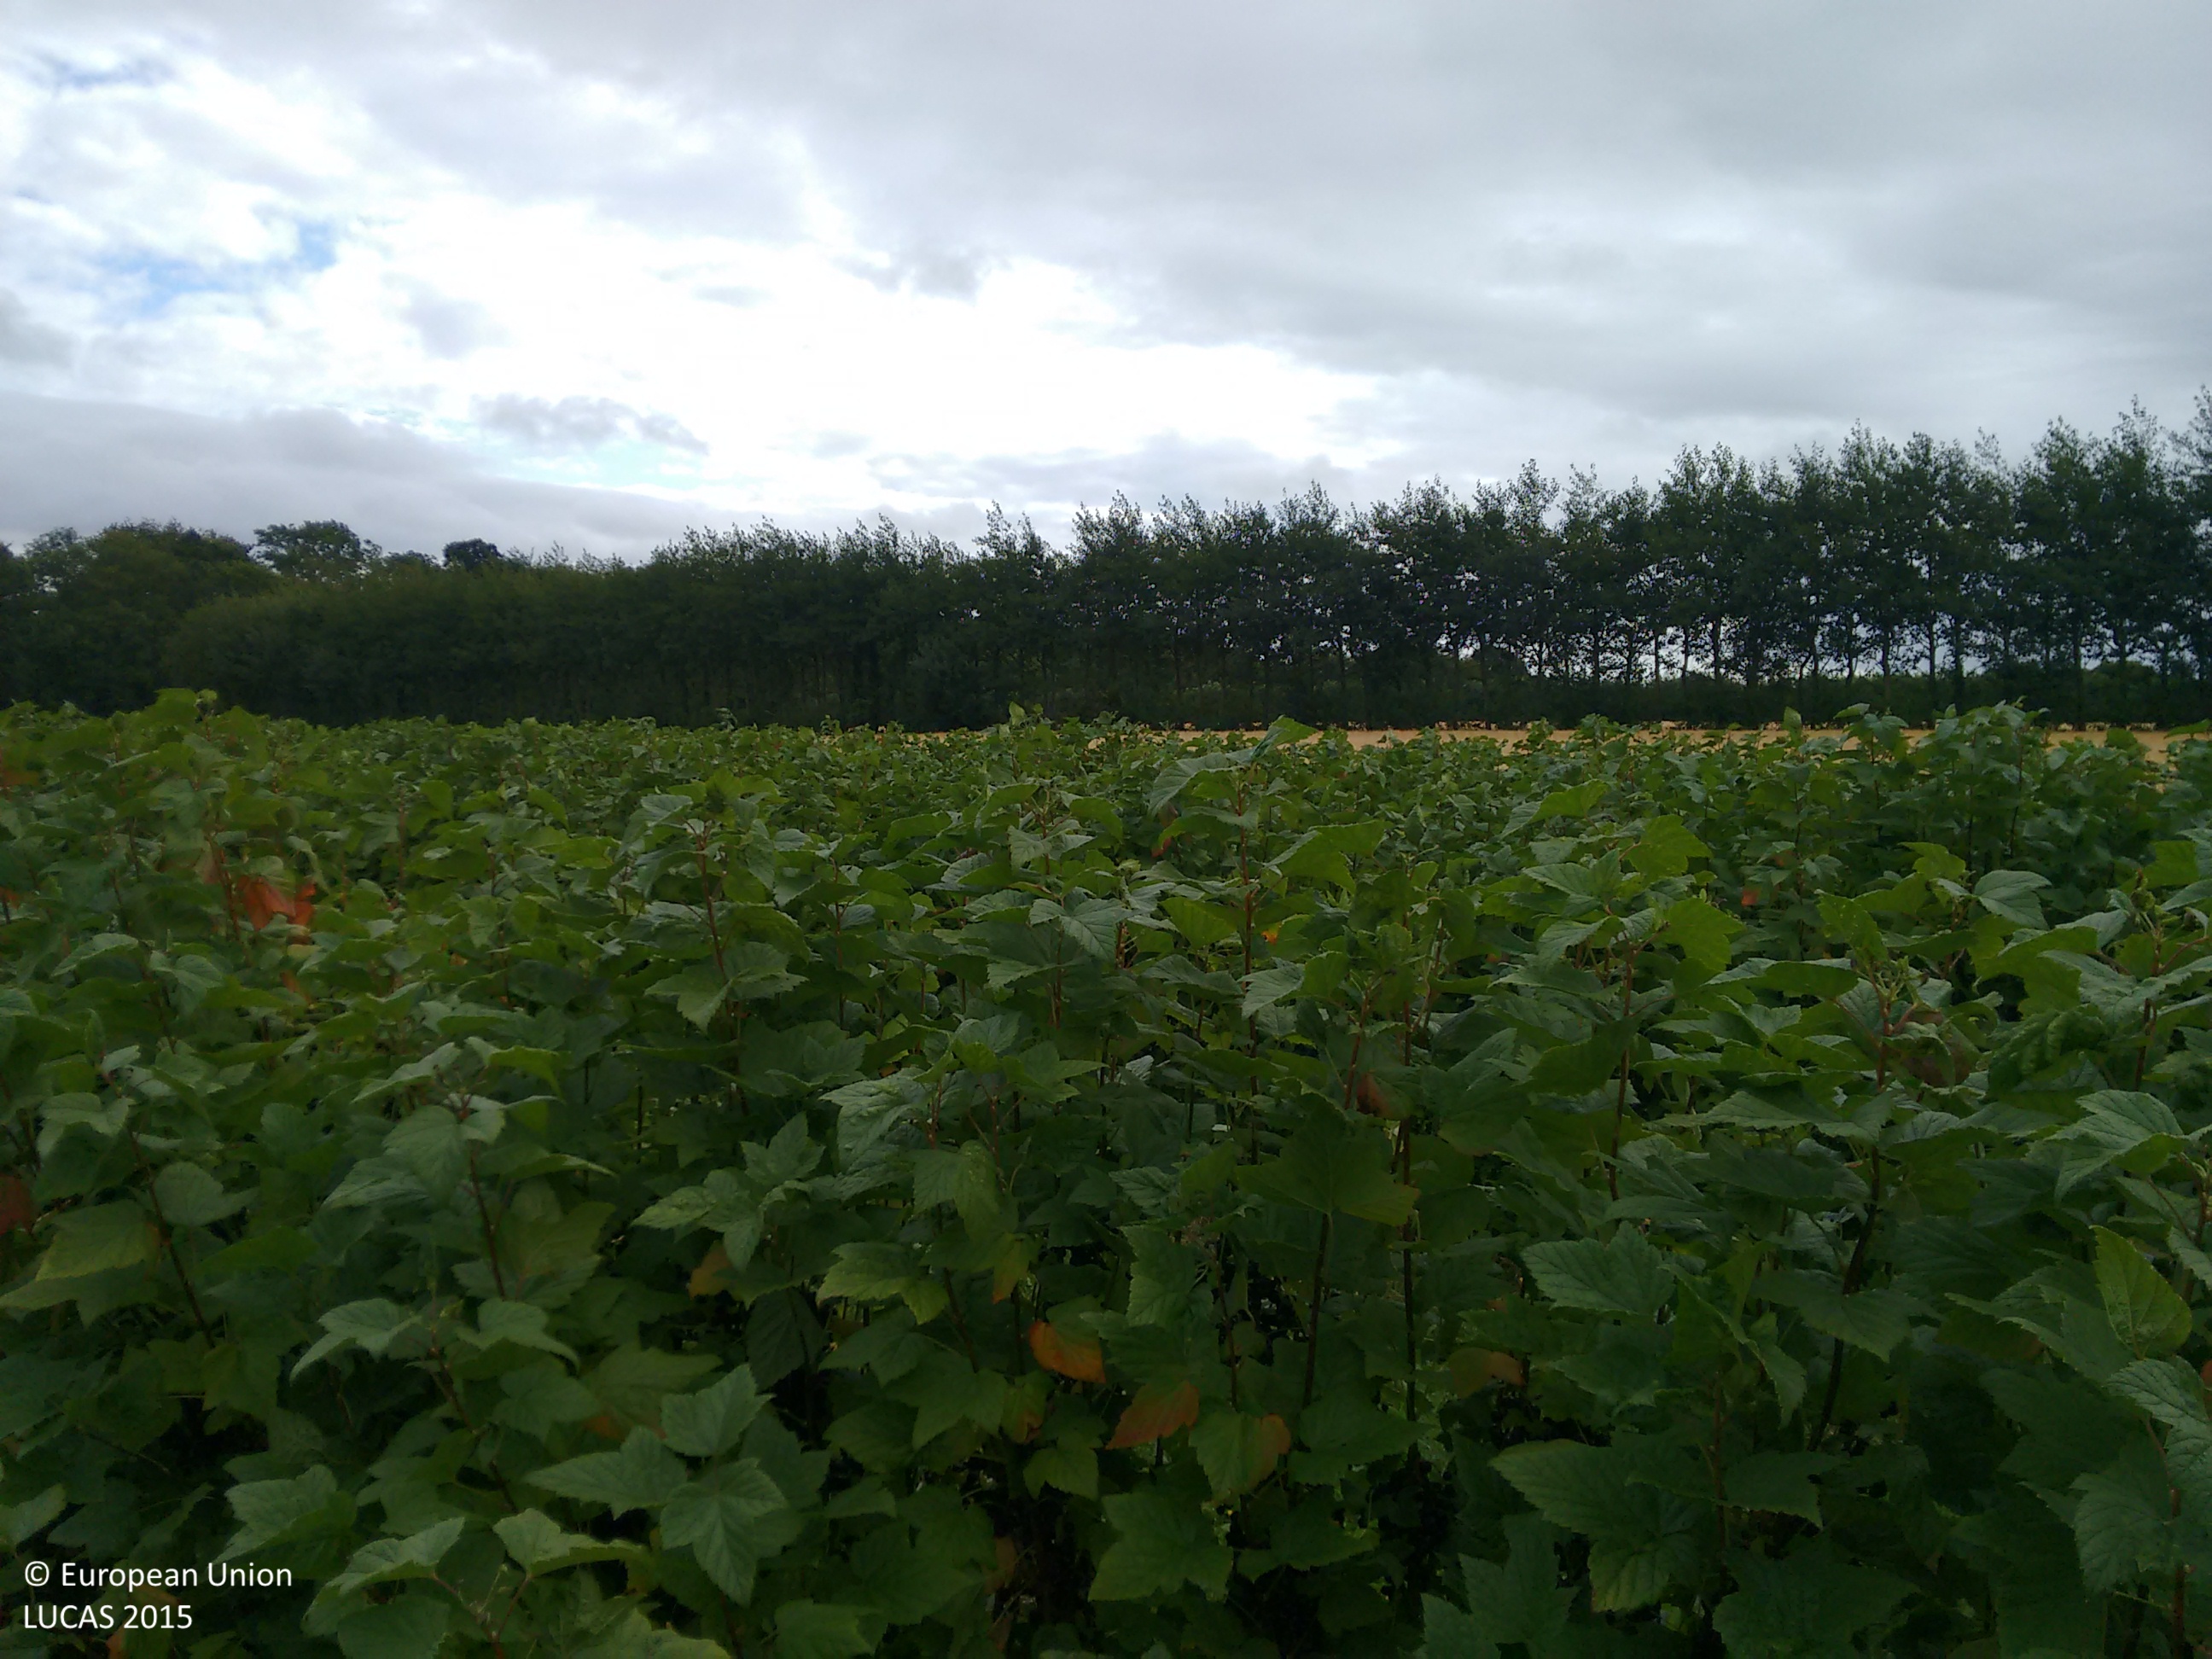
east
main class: Cropland
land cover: Other fruit trees and berries
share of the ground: 50 - 75 %
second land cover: Grassland without tree/shrub cover
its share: 50 - 75 %
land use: Agriculture (excluding fallow land and kitchen gardens)
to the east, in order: Other fruit trees and berries; Grassland without tree/shrub cover; Other fruit trees and berries; Abandoned hedges; Grass margins; Abandoned hedges; Grass margins; Abandoned hedges; Spontaneously vegetated surfaces; Barley; Abandoned hedges; Barley; Abandoned hedges; Fences; Grassland without tree/shrub cover
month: August
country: IE
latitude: 52.4995
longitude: -6.6147
